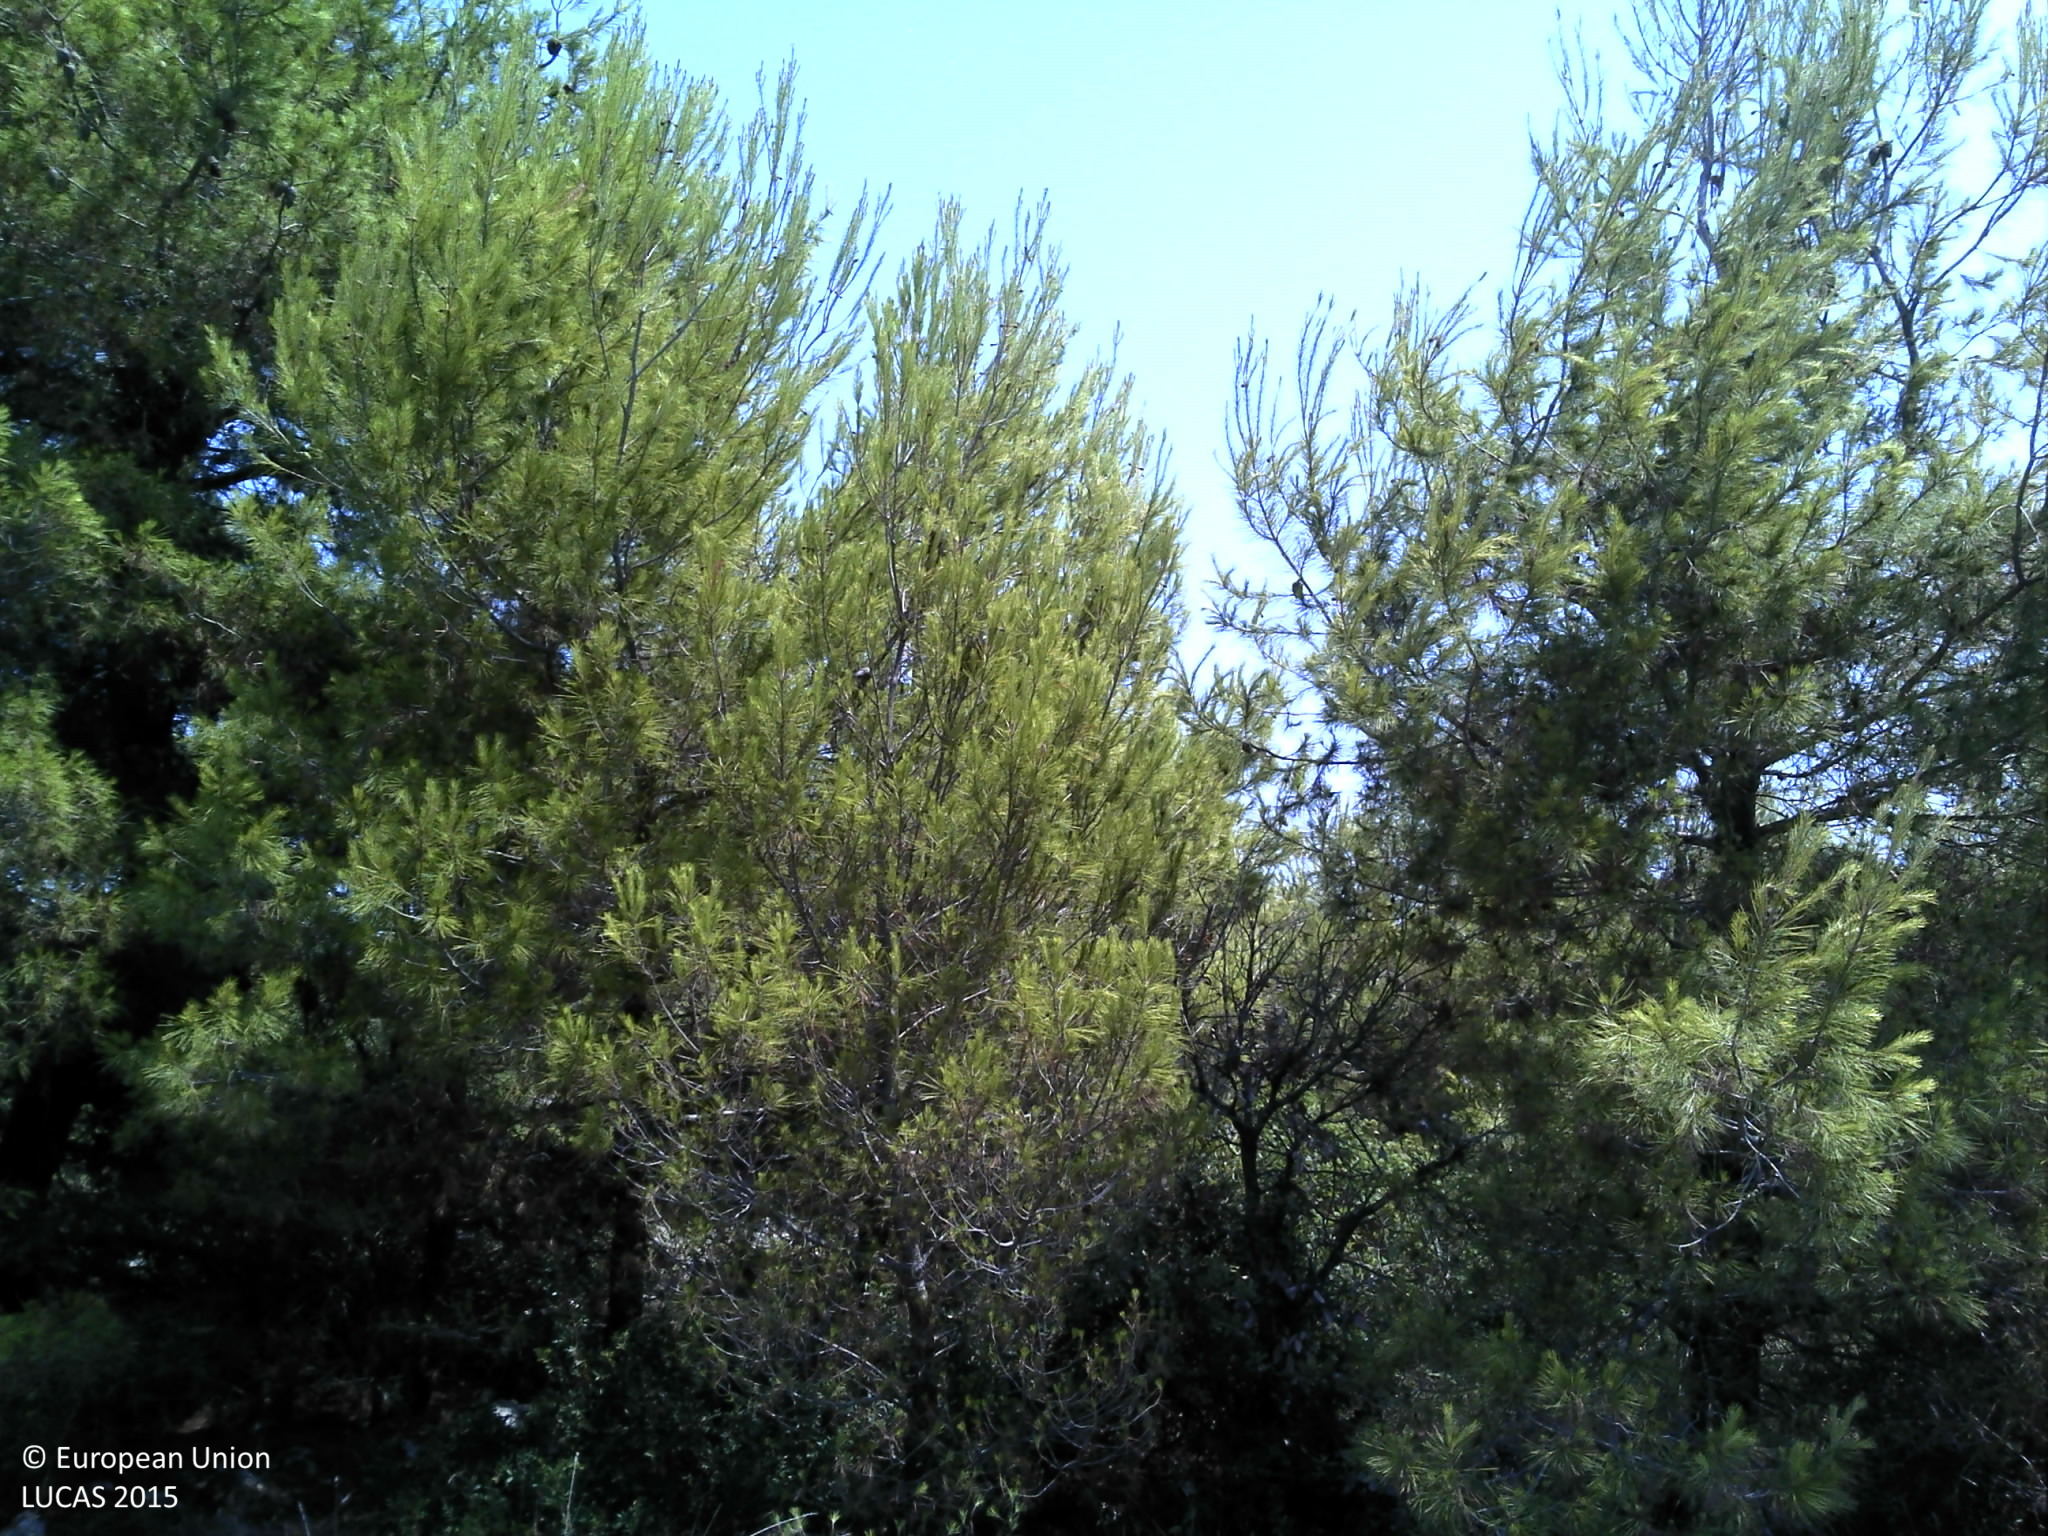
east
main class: Woodland
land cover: Pine dominated coniferous woodland
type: coniferous forest of the mediterranean region
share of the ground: 50 - 75 %
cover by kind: coniferous forest trees 50 %, shrubs 20 %, herbaceous plants 20 %, unconsolidated bare surface 10 %
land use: Semi-natural and natural areas not in use
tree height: > 5 m
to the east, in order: Pine dominated coniferous woodland; Shrubland with sparse tree cover; Dry stone walls; Shrubland with sparse tree cover; Dry stone walls; Pine dominated coniferous woodland; Dry stone walls; Pine dominated coniferous woodland; Dry stone walls; Pine dominated coniferous woodland
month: August
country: HR
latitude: 44.3002
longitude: 15.0438
